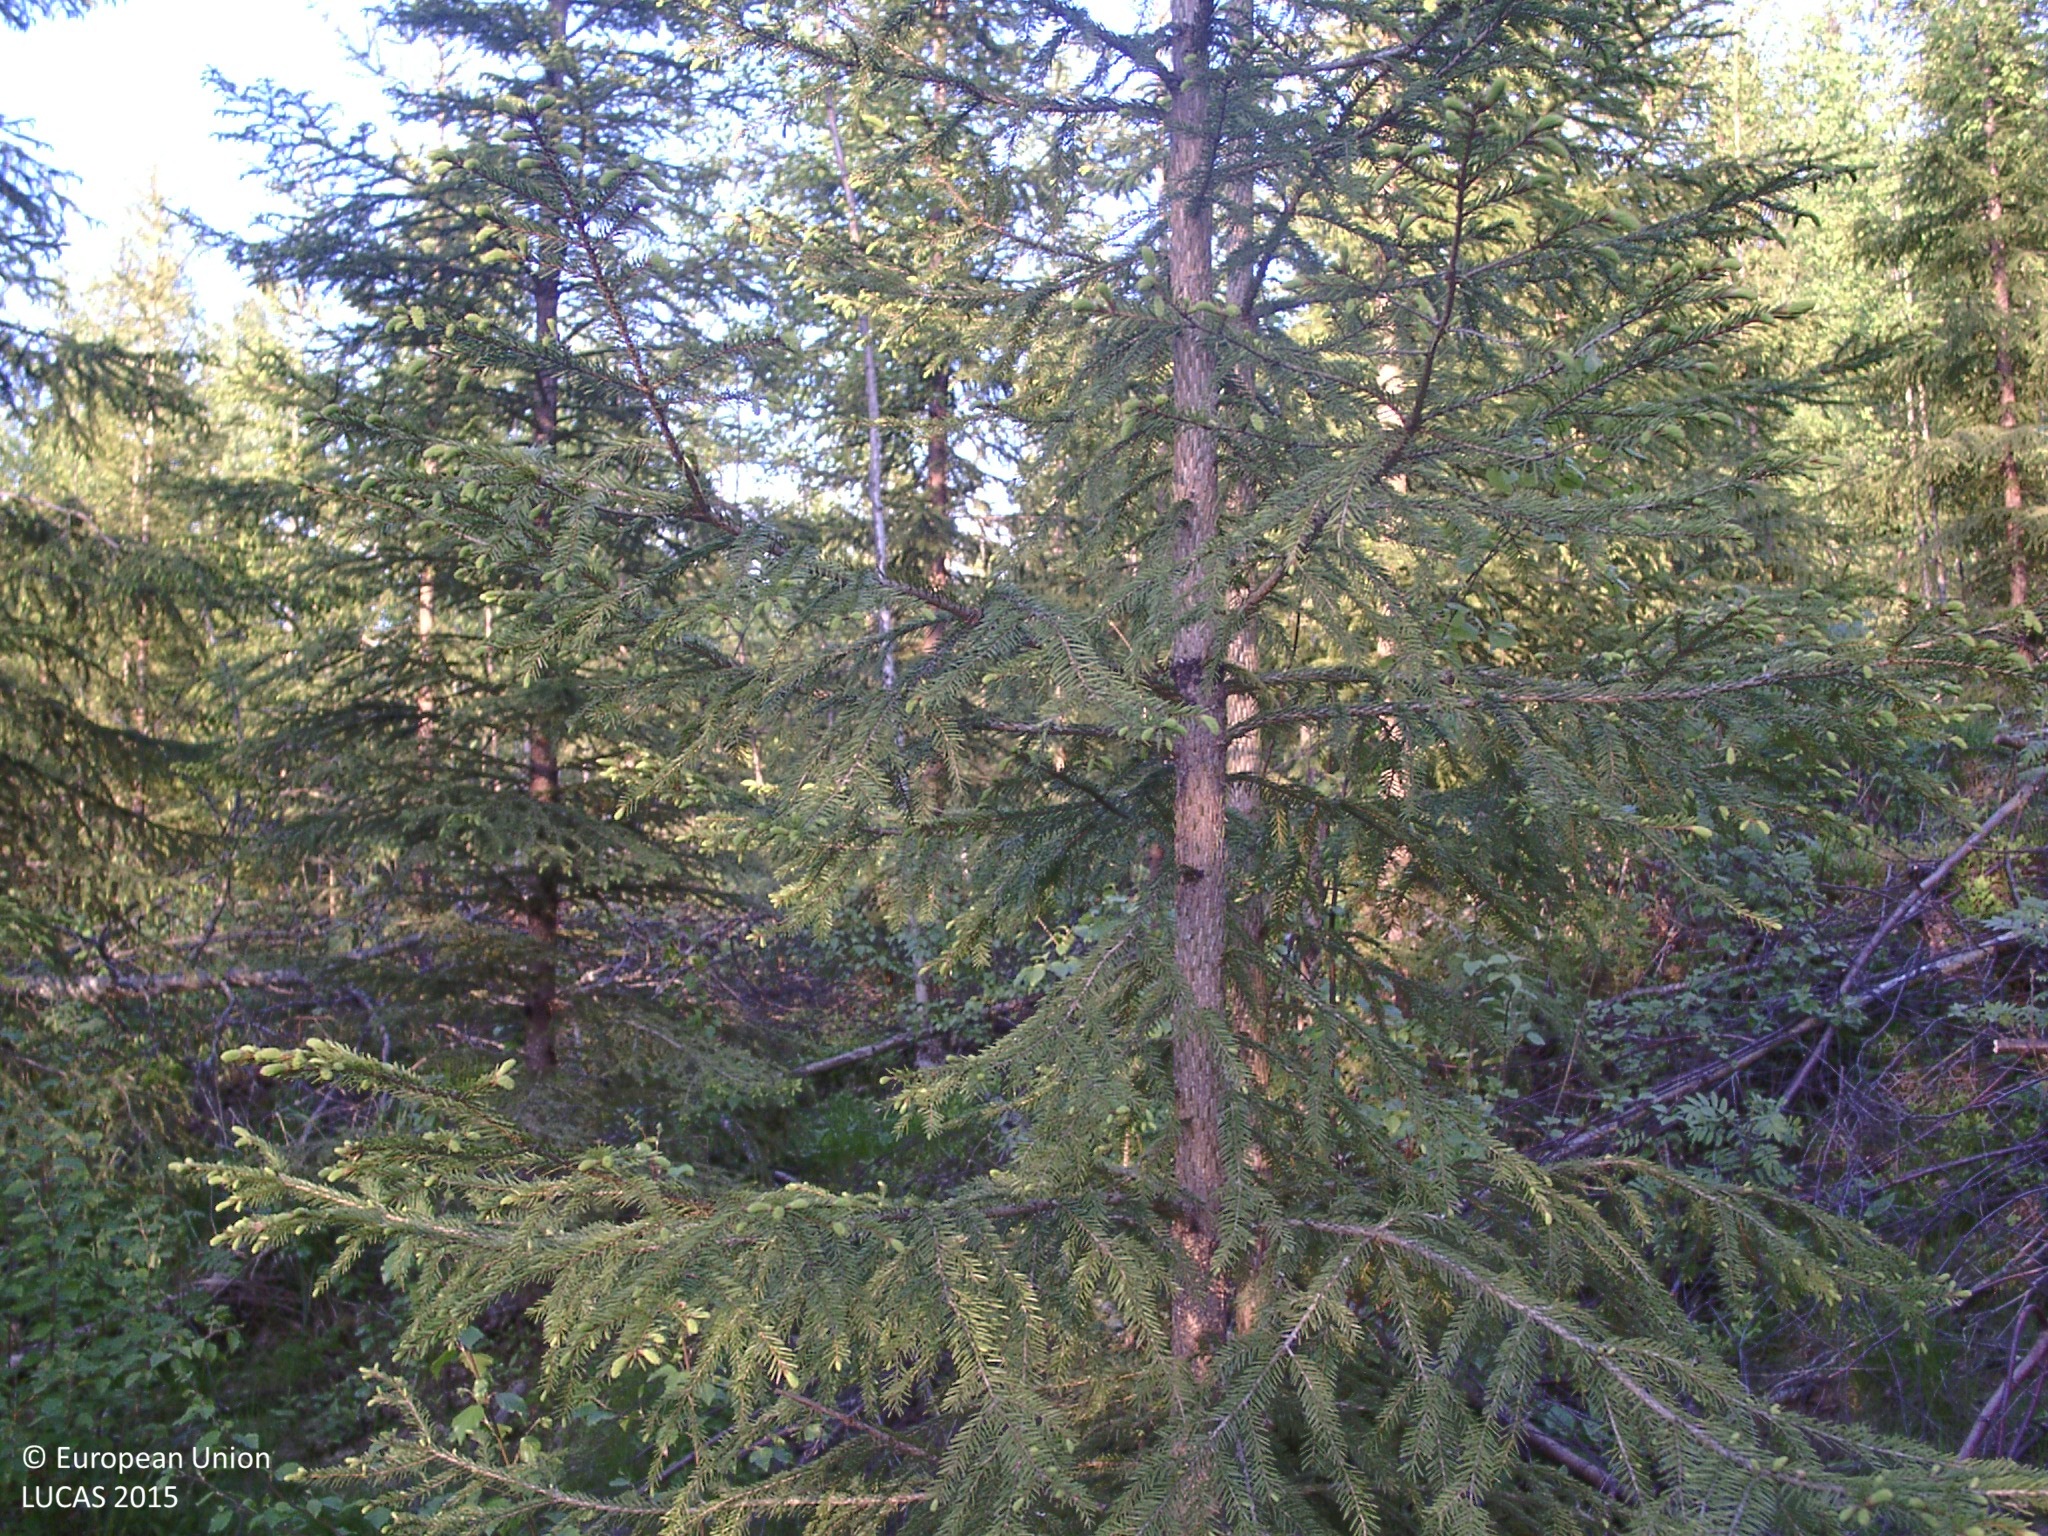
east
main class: Woodland
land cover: Spruce dominated mixed woodland
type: boreal forest
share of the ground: 50 - 75 %
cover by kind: broadleaved forest trees 35 %, coniferous forest trees 25 %, herbaceous plants 20 %, shrubs 5 %, lichens and mosses 5 %
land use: Forestry
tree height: < 5 m
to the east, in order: Spruce dominated mixed woodland
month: June
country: FI
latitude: 62.1773
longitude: 25.6165
